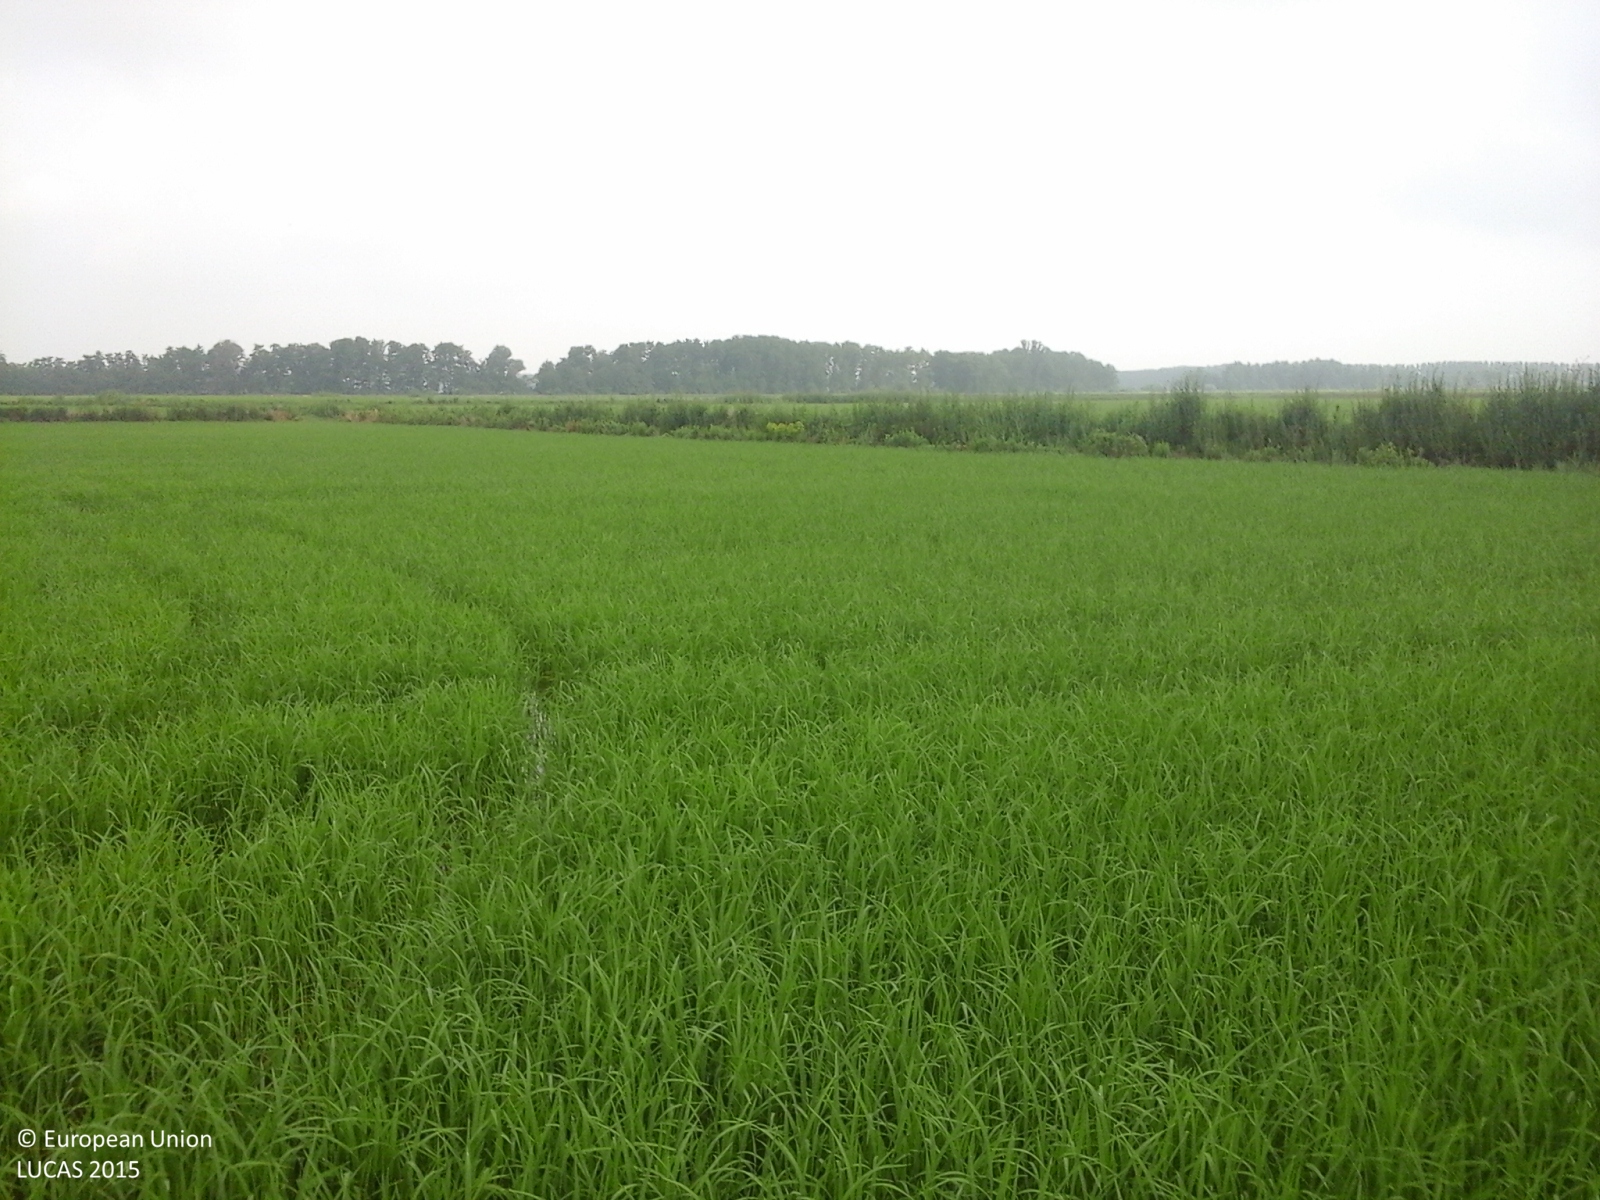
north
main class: Cropland
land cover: Rice
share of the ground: > 75 %
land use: Agriculture (excluding fallow land and kitchen gardens)
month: June
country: IT
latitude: 45.2072
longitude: 8.6402
